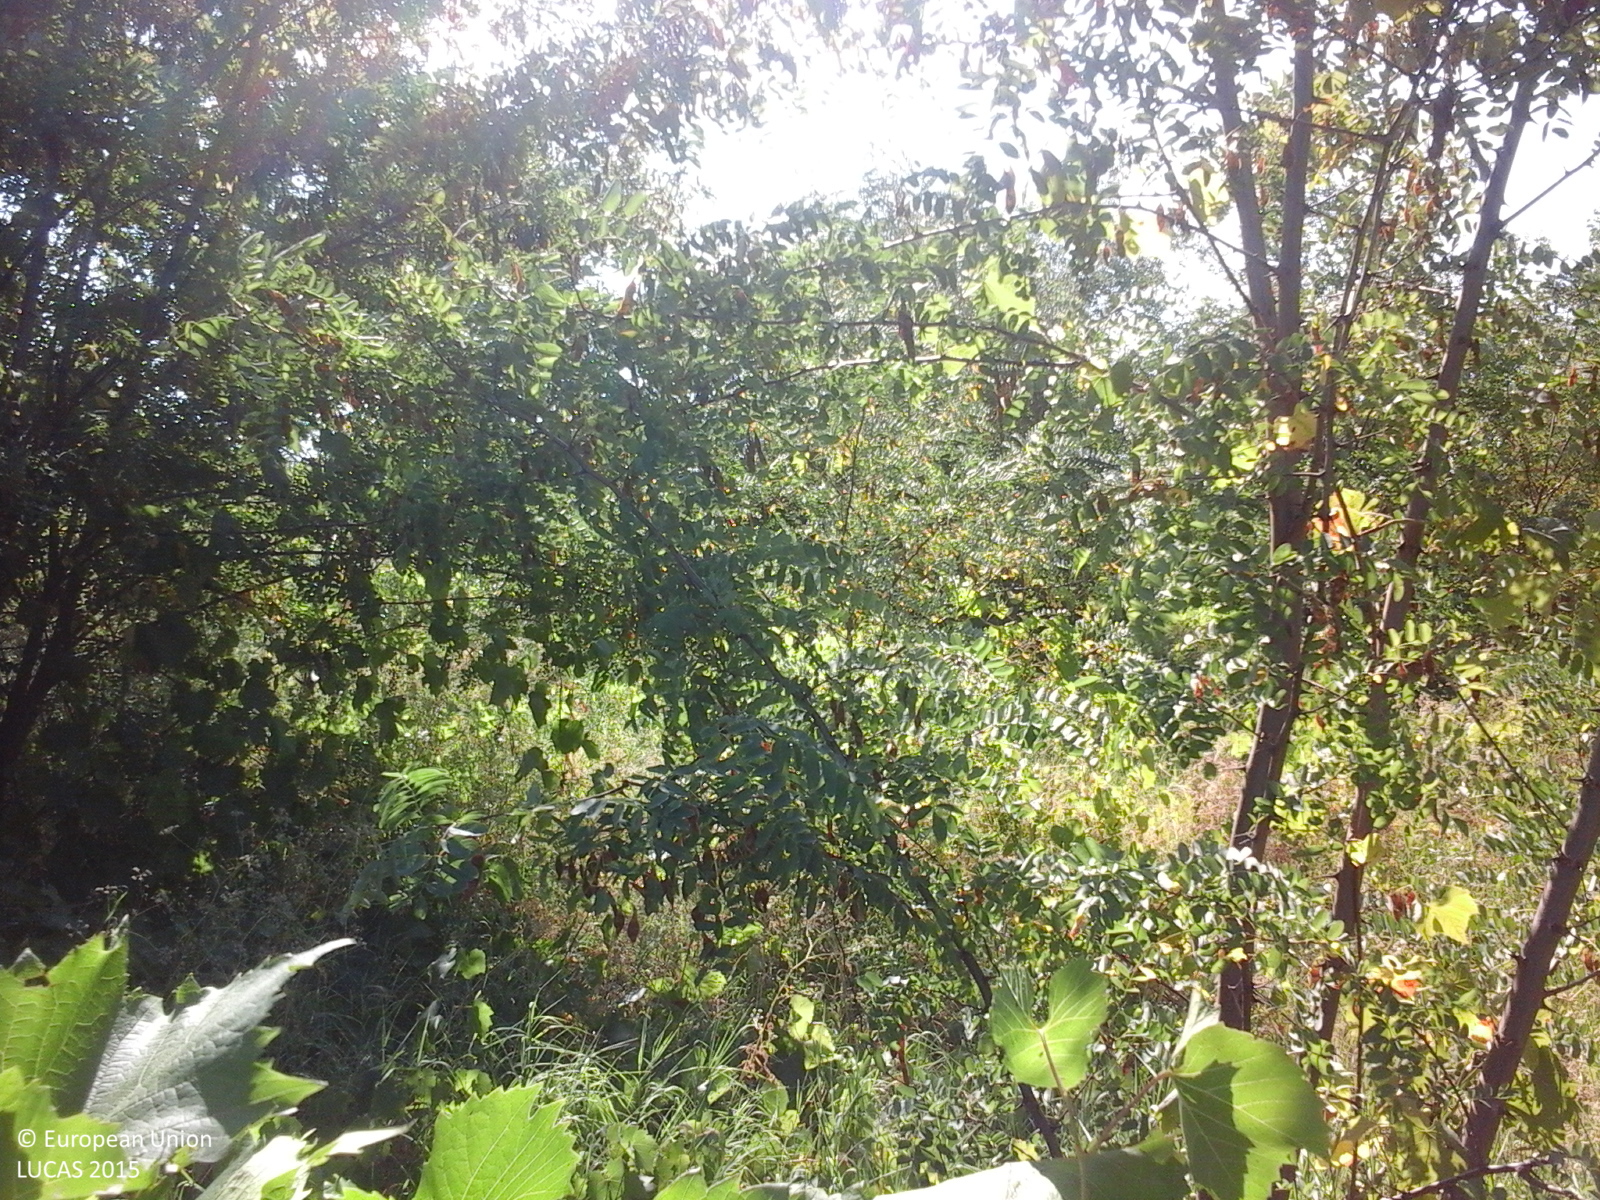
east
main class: Cropland
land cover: Vineyards
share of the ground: > 75 %
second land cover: Other bare soil
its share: > 75 %
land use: Agriculture (excluding fallow land and kitchen gardens)
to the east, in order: Vineyards; Other bare soil; Shrubland with sparse tree cover; Common wheat; Tracks; Common wheat; Electric lines; Common wheat; Maize; Common wheat; Electric lines; Common wheat; Lucerne
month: July
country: RO
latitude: 46.3441
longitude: 27.8562
